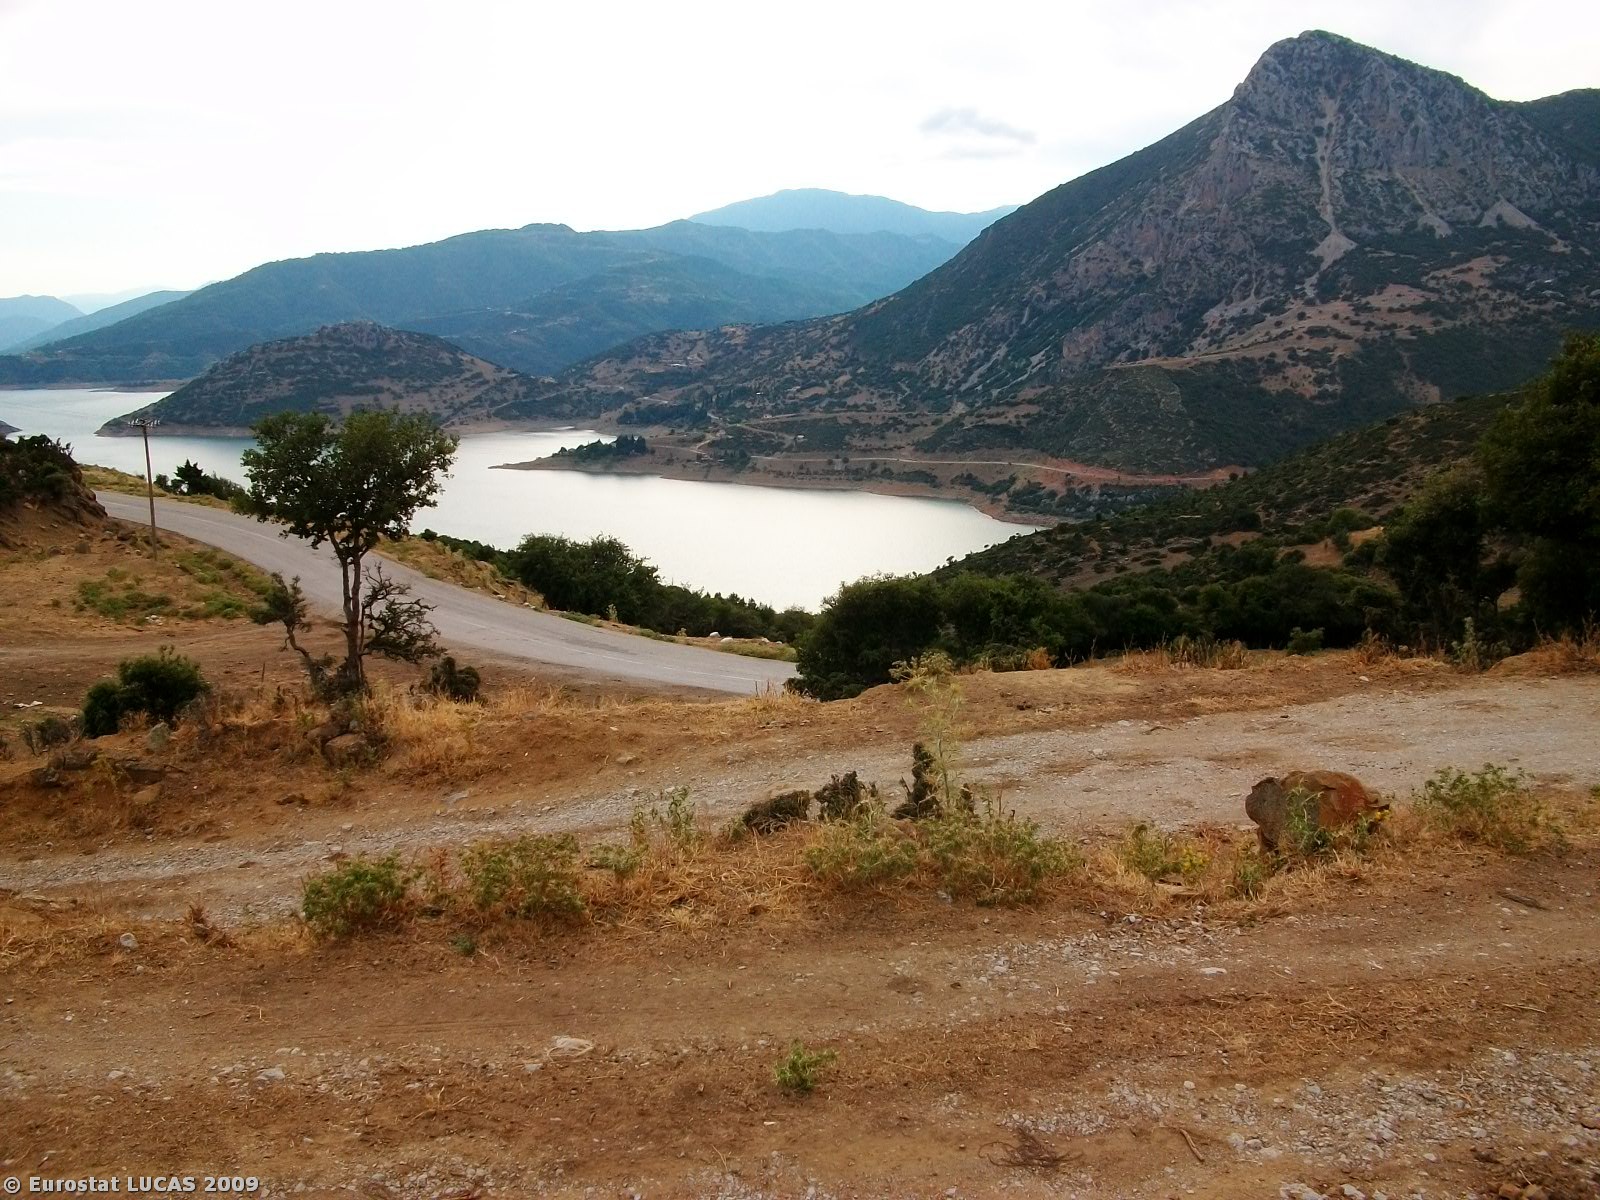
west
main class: Grassland
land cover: Grassland with sparse tree/shrub cover
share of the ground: 50 - 75 %
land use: Agriculture (excluding fallow land and kitchen gardens)
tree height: < 5 m
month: June
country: GR
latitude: 38.5525
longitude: 22.1950
